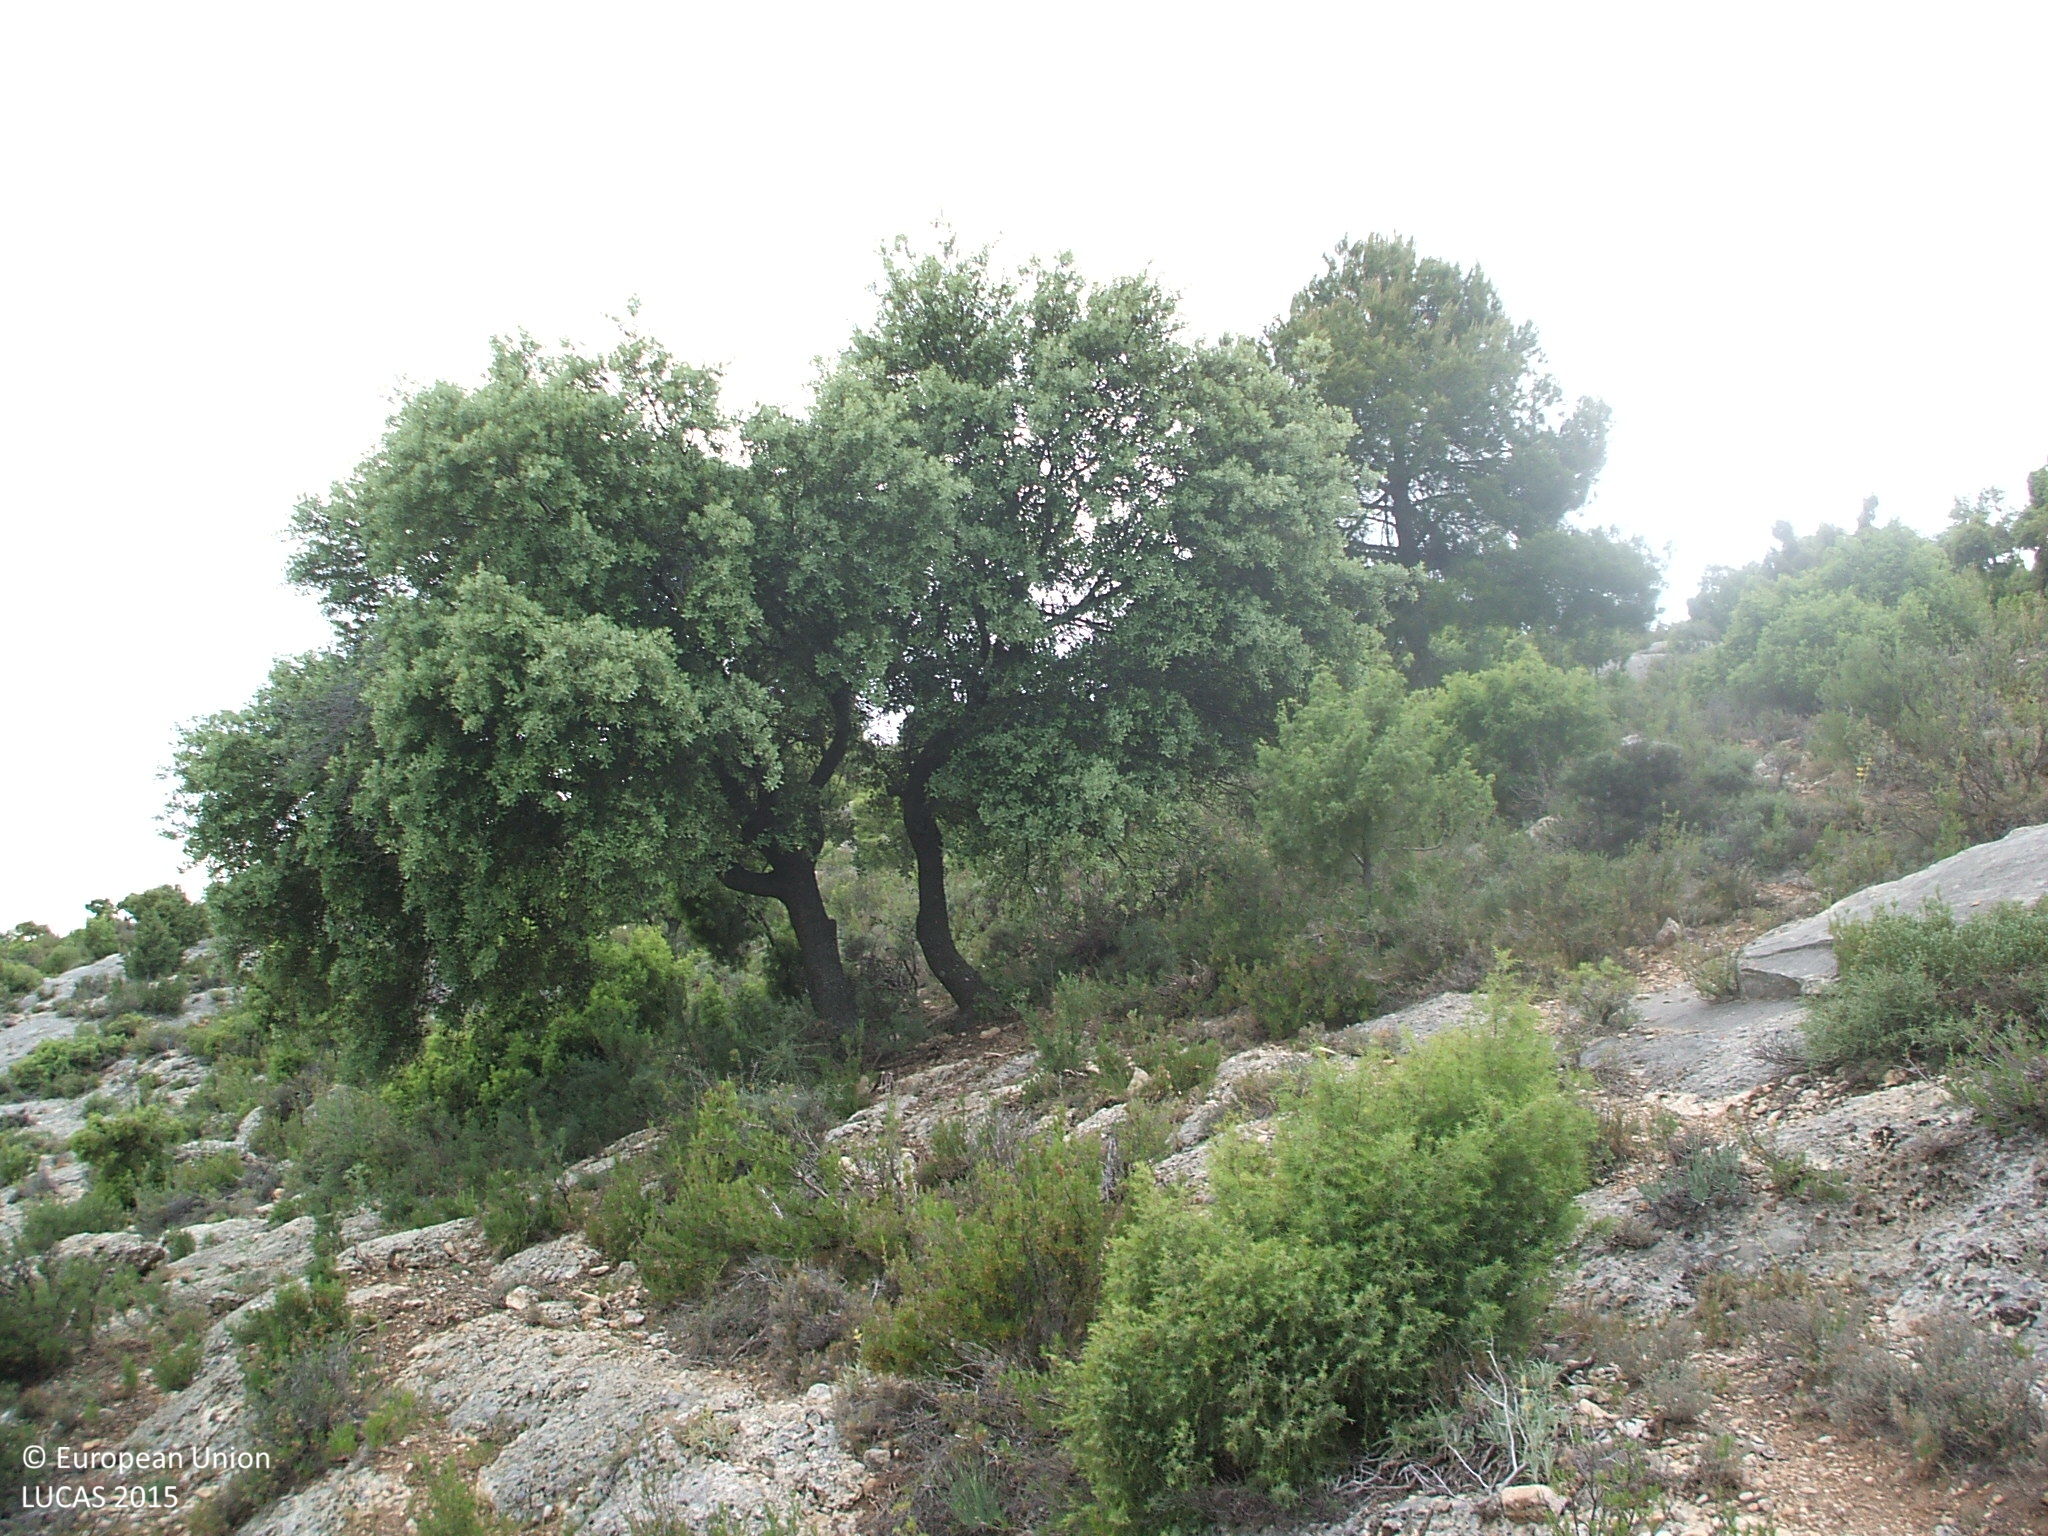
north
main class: Shrubland
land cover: Shrubland with sparse tree cover
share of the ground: 50 - 75 %
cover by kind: consolidated bare surface 55 %, shrubs 40 %, broadleaved forest trees 5 %
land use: Semi-natural and natural areas not in use
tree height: > 5 m
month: June
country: ES
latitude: 40.8424
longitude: -0.0548
